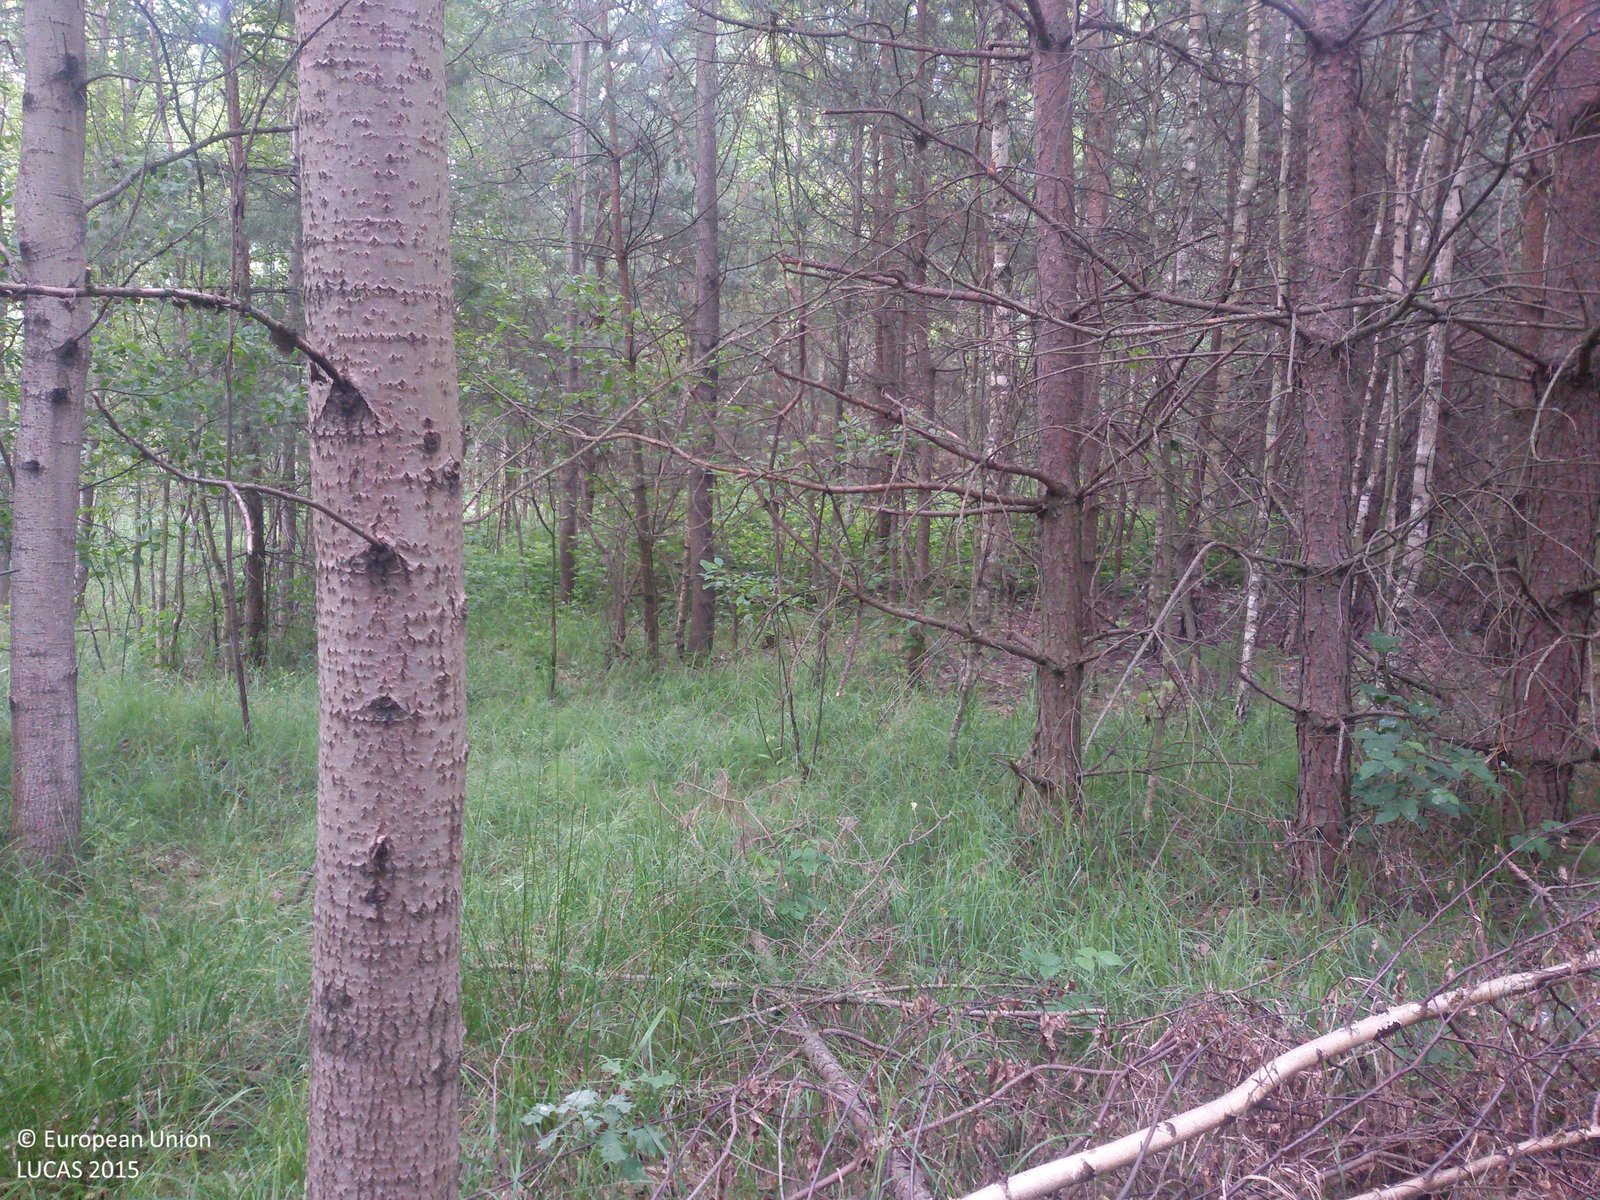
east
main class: Woodland
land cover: Pine dominated mixed woodland
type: hemiboreal forest and nemoral coniferous forest and mixed broadleaved-coniferous forest
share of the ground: > 75 %
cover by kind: coniferous forest trees 75 %, broadleaved forest trees 25 %
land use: Forestry
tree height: > 5 m
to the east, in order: Pine dominated mixed woodland; Pine dominated coniferous woodland; Grassland without tree/shrub cover; Oats; Pine dominated mixed woodland; Grassland with sparse tree/shrub cover; Pine dominated coniferous woodland
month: June
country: PL
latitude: 51.1584
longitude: 20.9826
